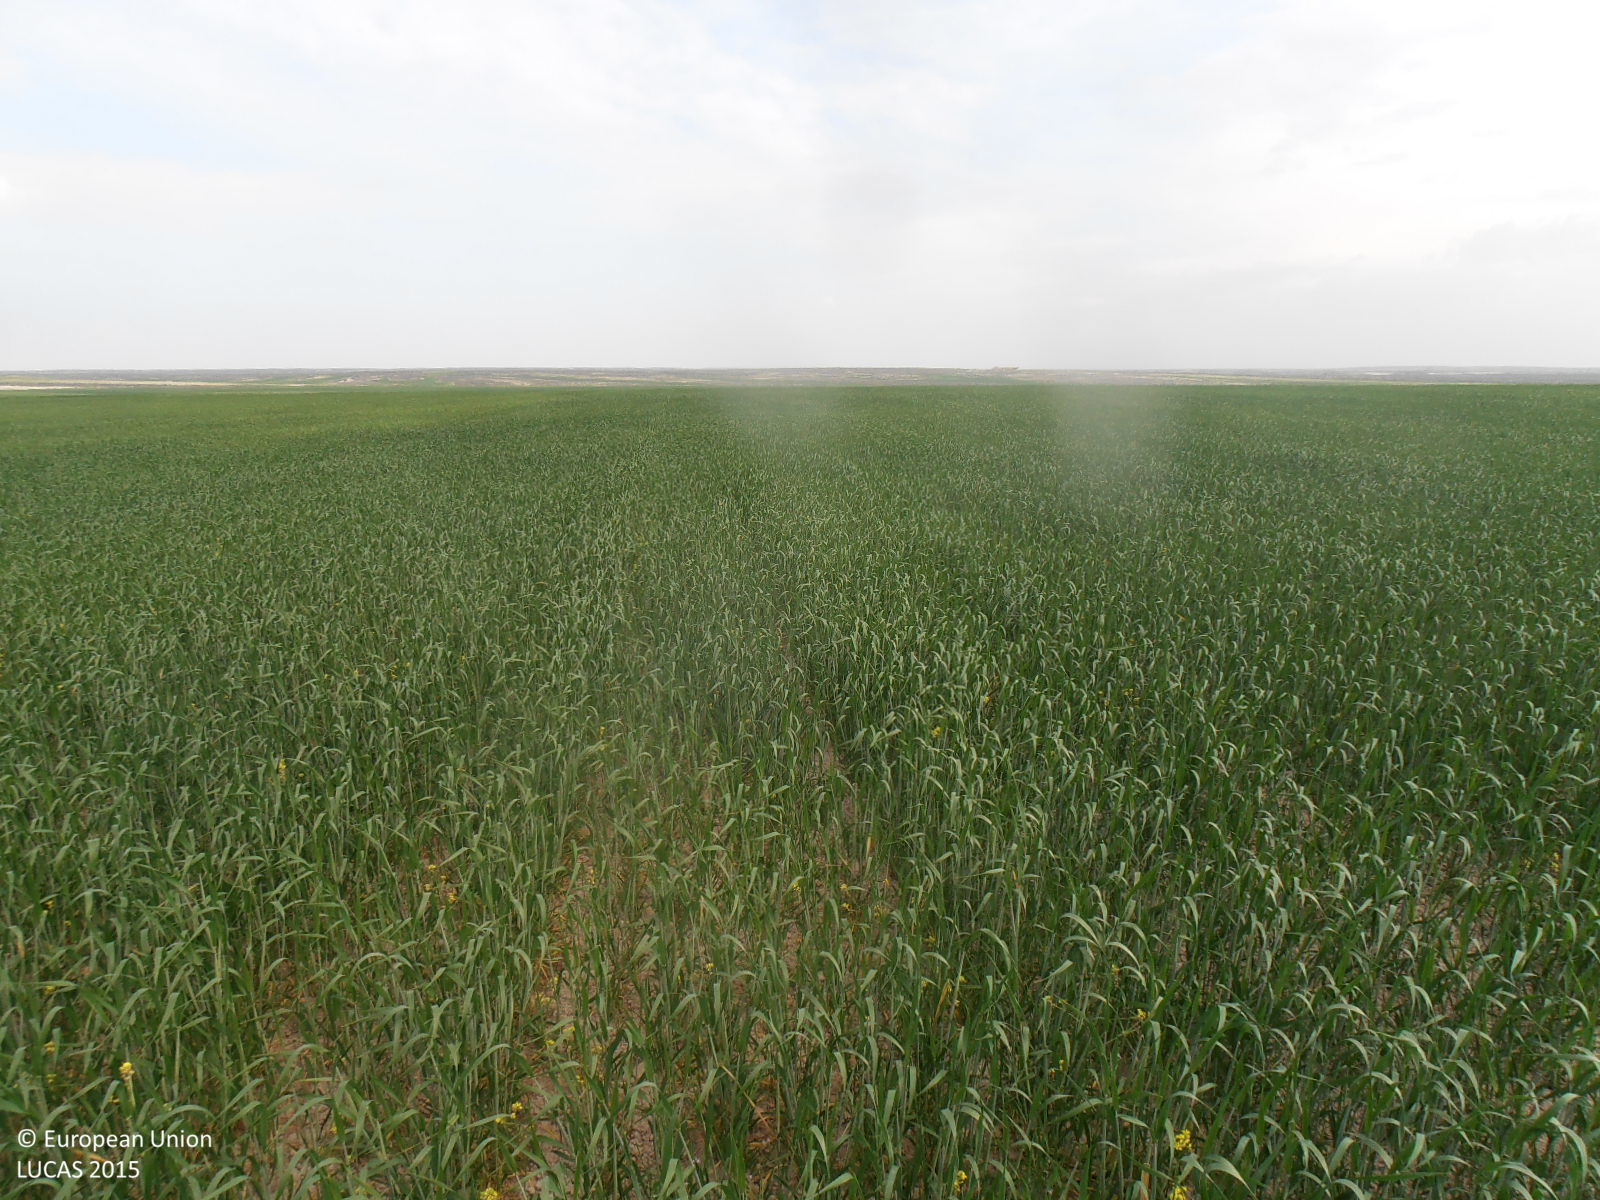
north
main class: Cropland
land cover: Durum wheat
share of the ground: > 75 %
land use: Agriculture (excluding fallow land and kitchen gardens)
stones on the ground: < 10 %
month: April
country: ES
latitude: 41.3888
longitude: -0.7456
